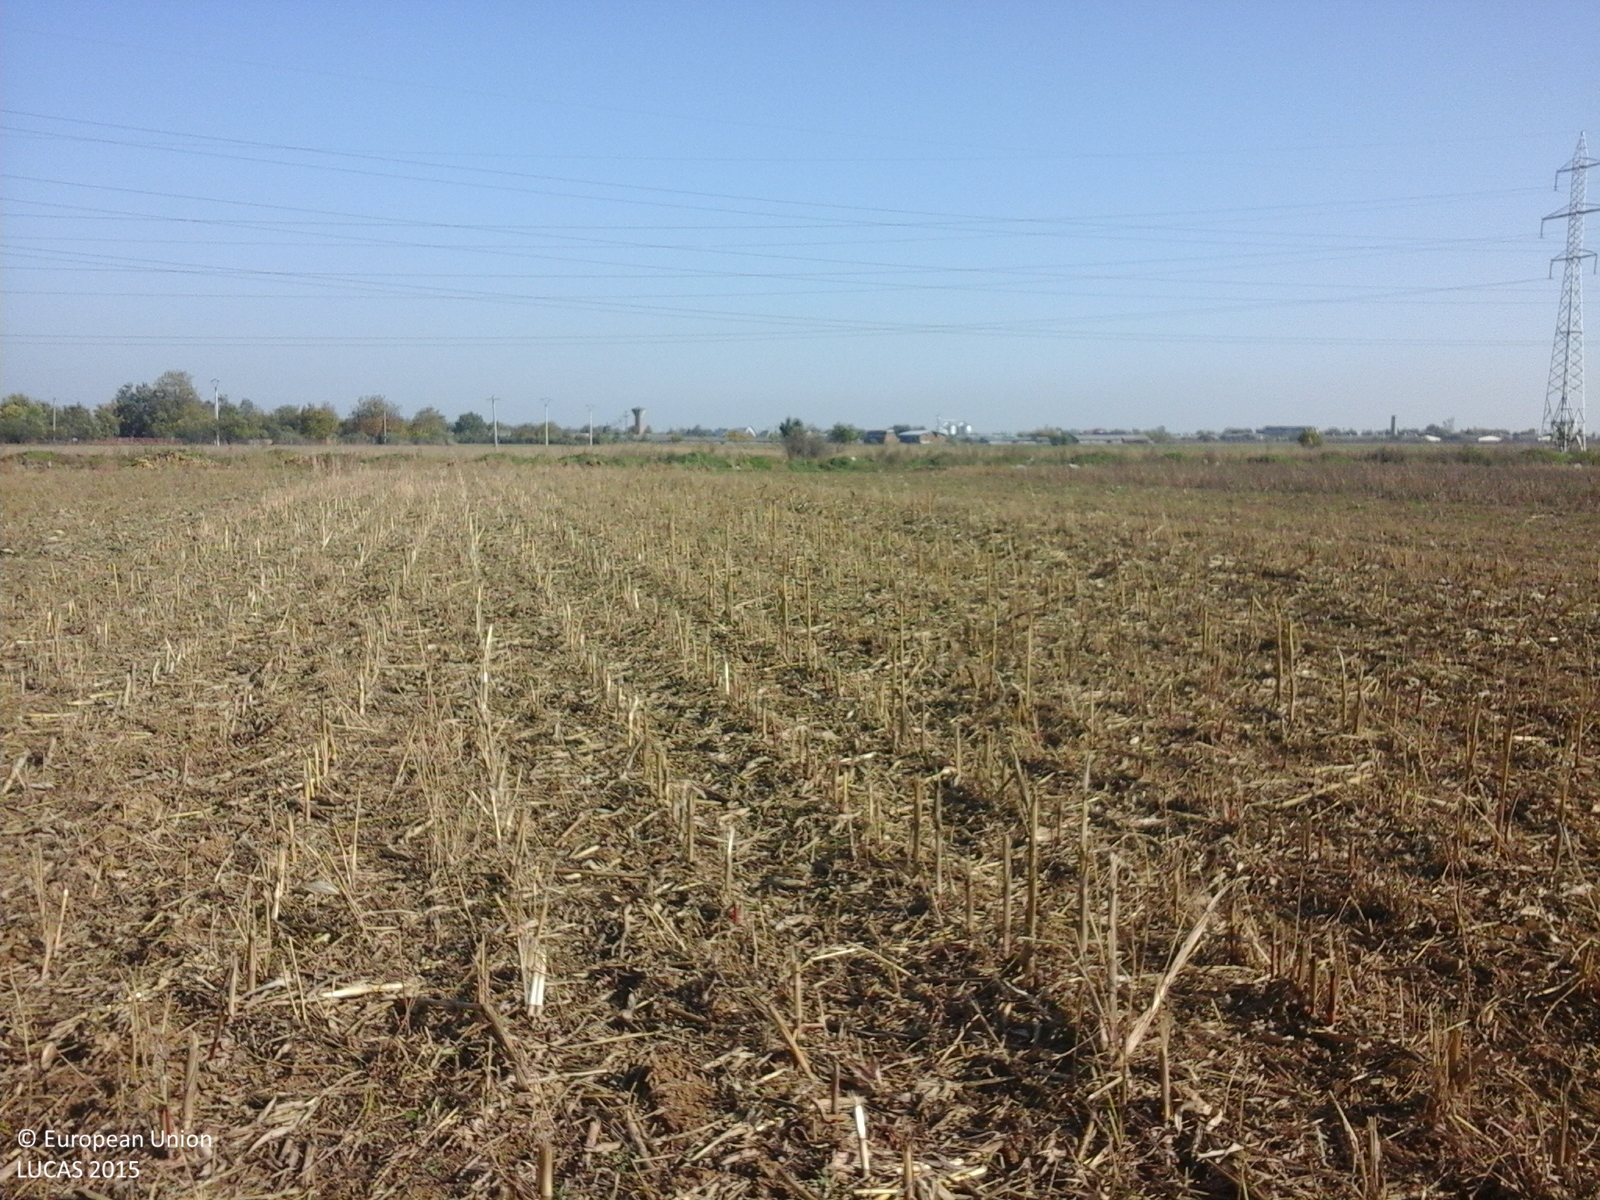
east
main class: Cropland
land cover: Maize
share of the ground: < 10 %
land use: Agriculture (excluding fallow land and kitchen gardens)
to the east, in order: Maize; Tracks; Abandoned hedges; Ditches and canals; Grassland without tree/shrub cover; Electric lines; Grassland without tree/shrub cover
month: October
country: RO
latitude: 45.1332
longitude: 26.7214
